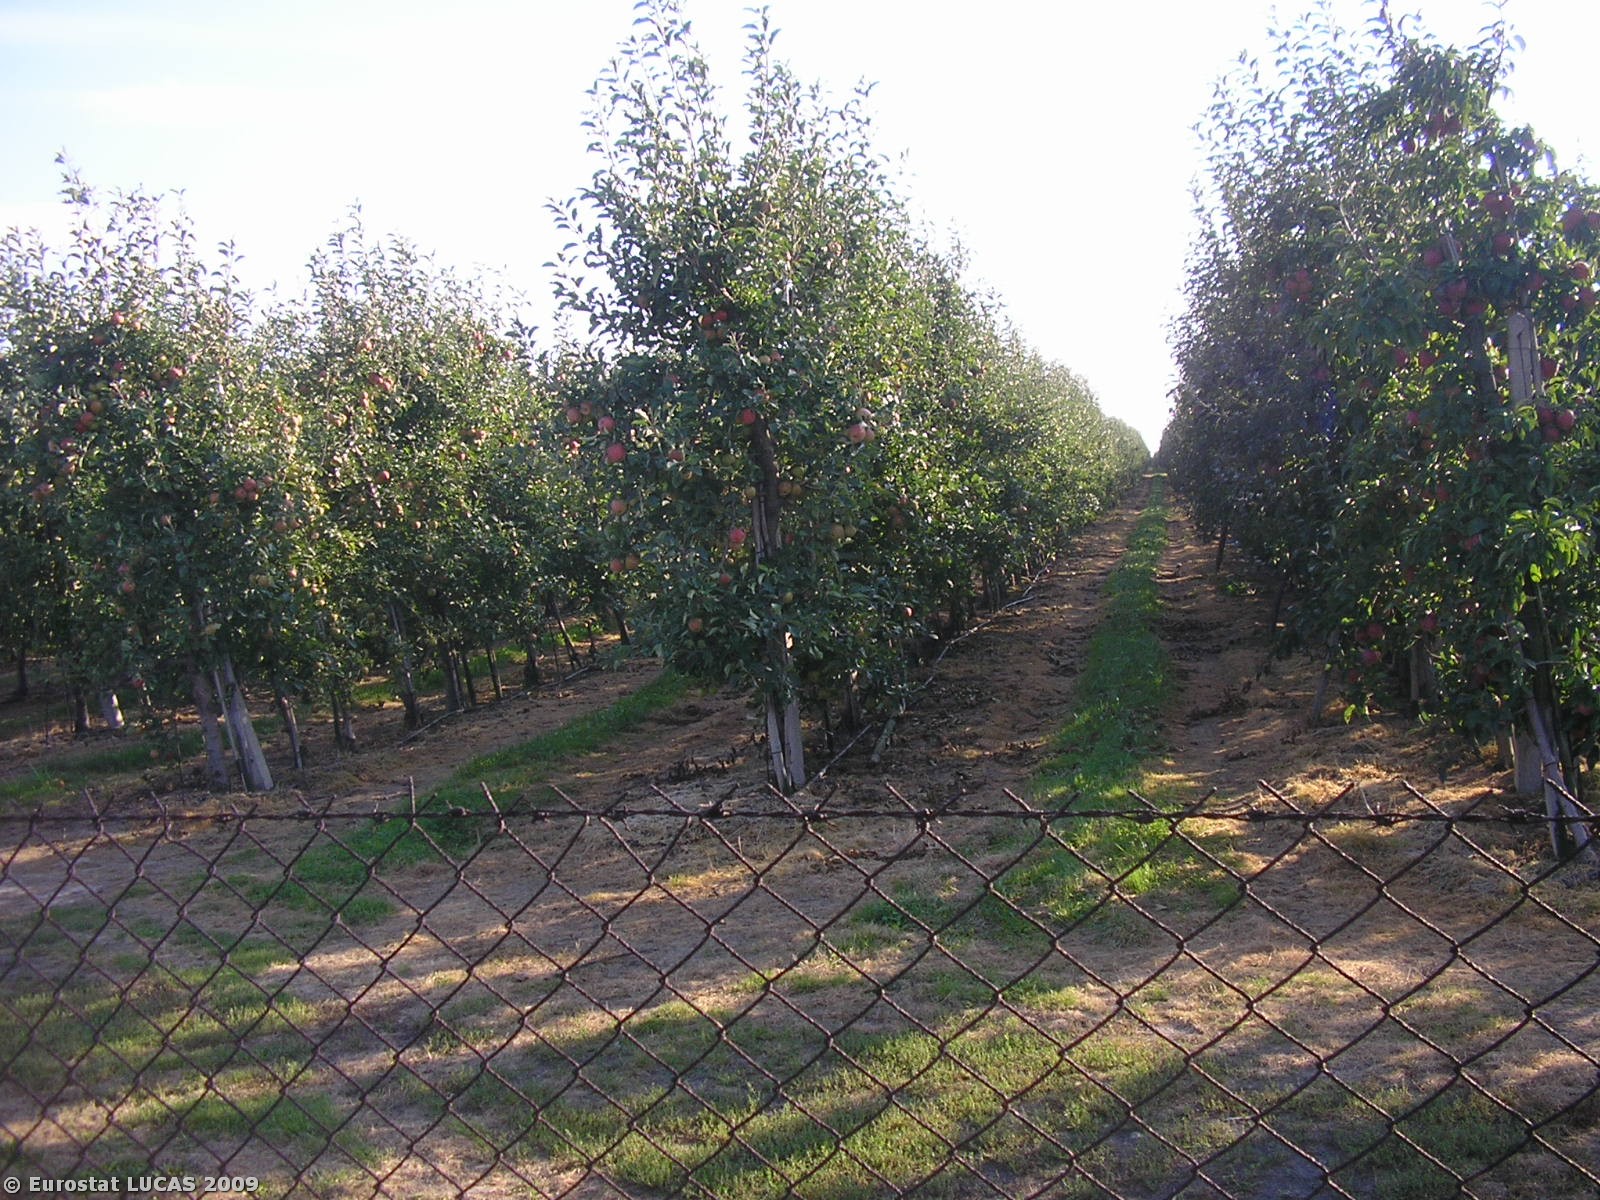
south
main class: Cropland
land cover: Apple fruit
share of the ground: 25 - 50 %
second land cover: Grassland with sparse tree/shrub cover
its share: > 75 %
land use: Agriculture (excluding fallow land and kitchen gardens)
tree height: < 5 m
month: September
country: PL
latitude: 51.8043
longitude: 20.6707
